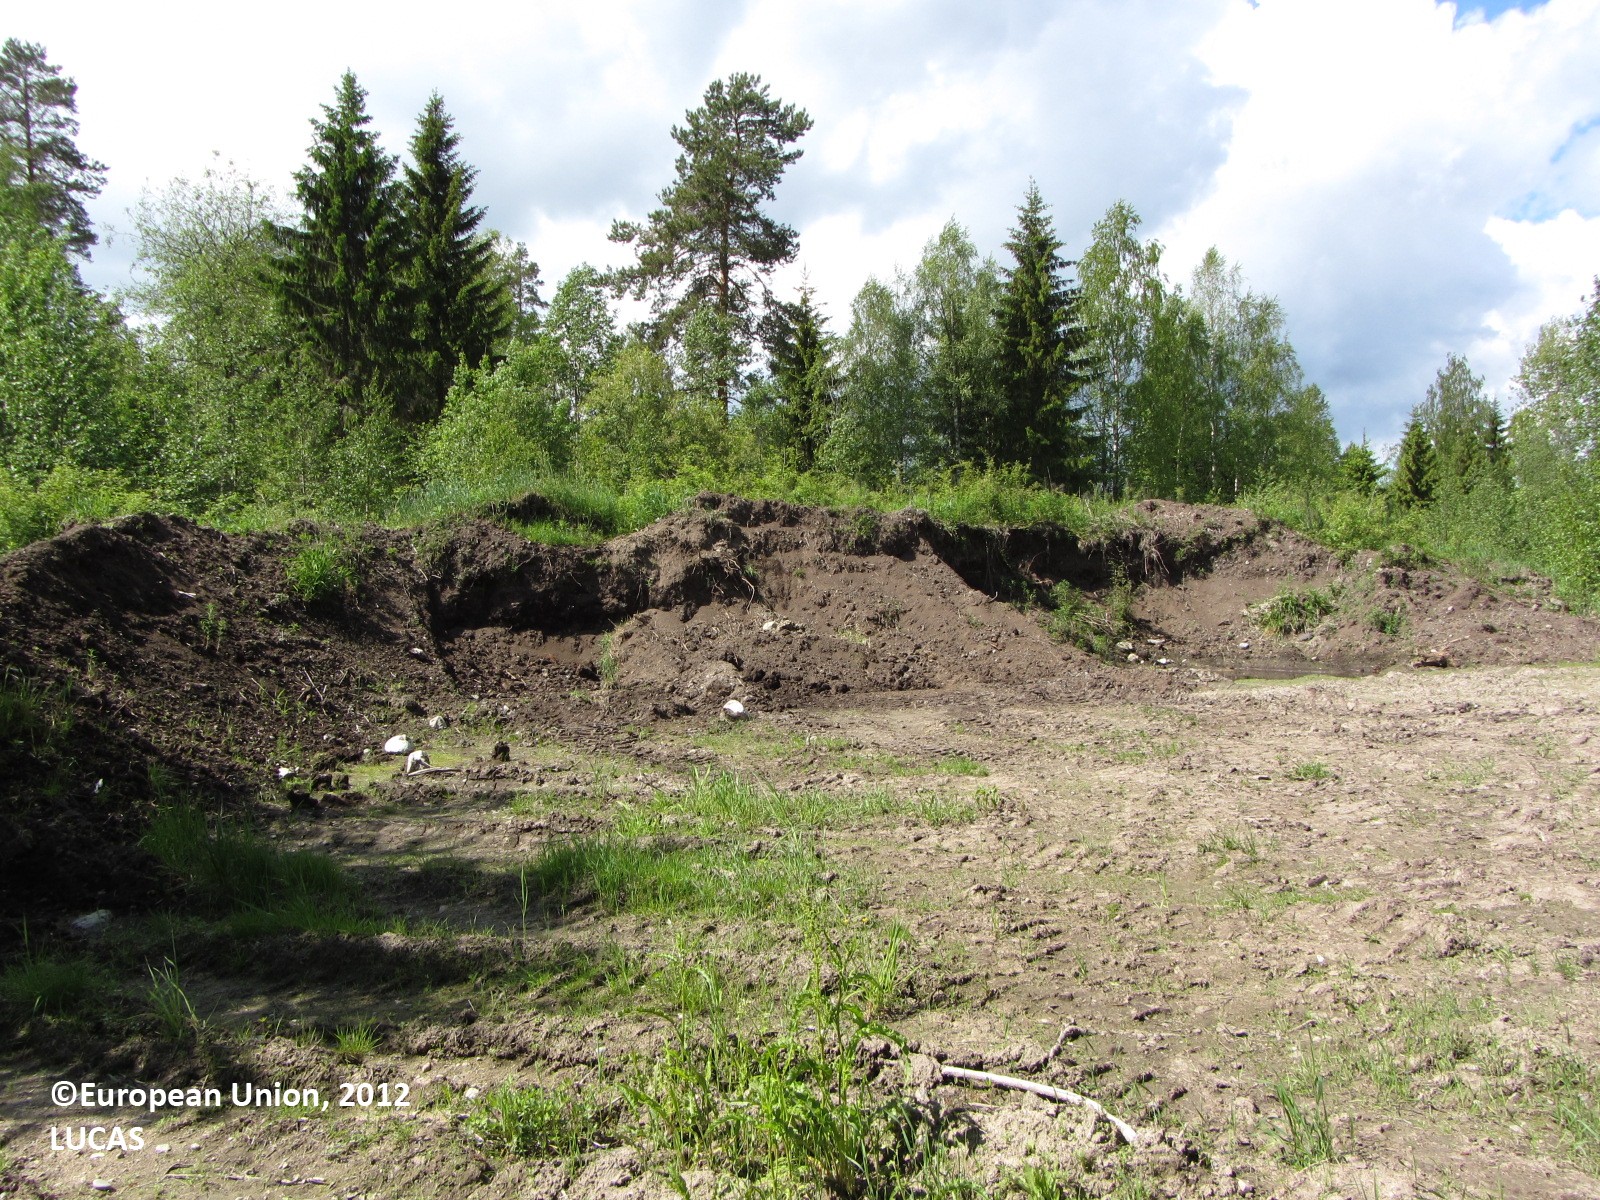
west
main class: Grassland
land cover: Spontaneously vegetated surfaces
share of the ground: 50 - 75 %
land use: Semi-natural and natural areas not in use
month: June
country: FI
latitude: 61.9953
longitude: 24.7030
